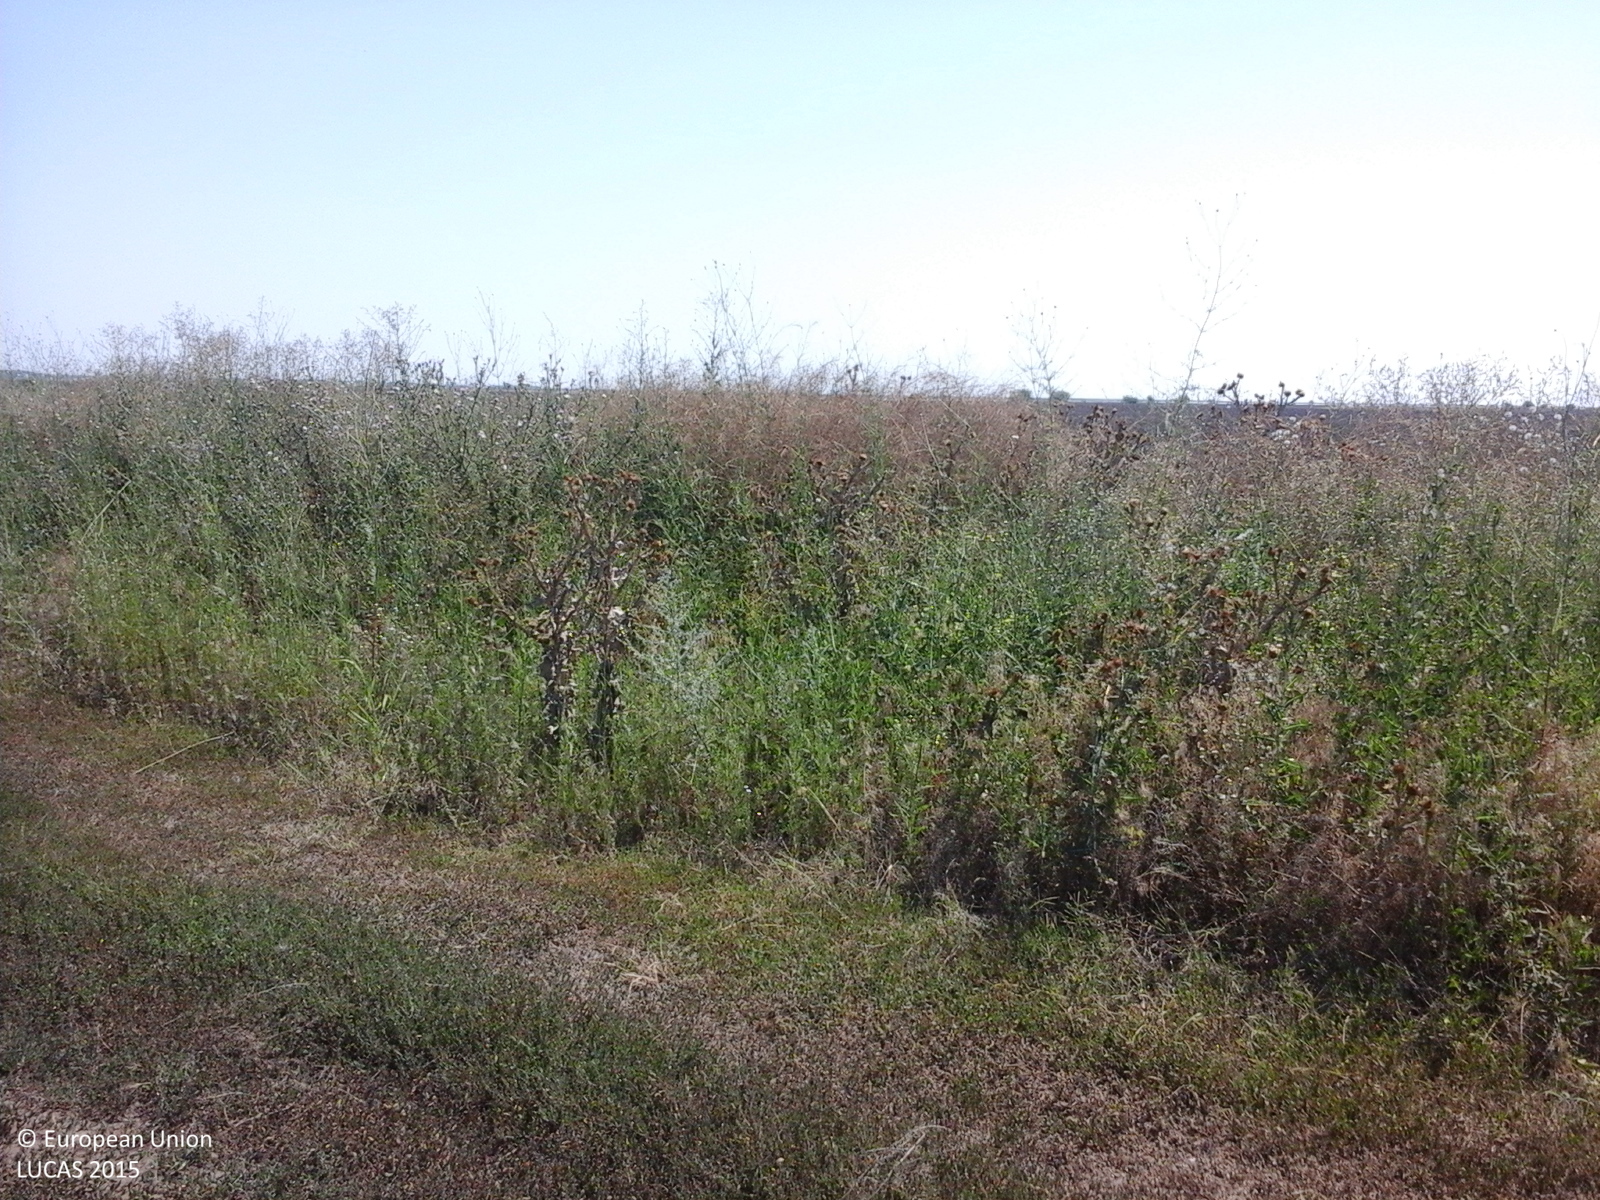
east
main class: Cropland
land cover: Maize
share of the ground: > 75 %
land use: Agriculture (excluding fallow land and kitchen gardens)
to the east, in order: Maize; Grass margins; Tracks; Spontaneously vegetated surfaces; Ditches and canals; Spontaneously vegetated surfaces; Tracks; Other bare soil
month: July
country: RO
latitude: 44.3315
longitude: 27.1233
